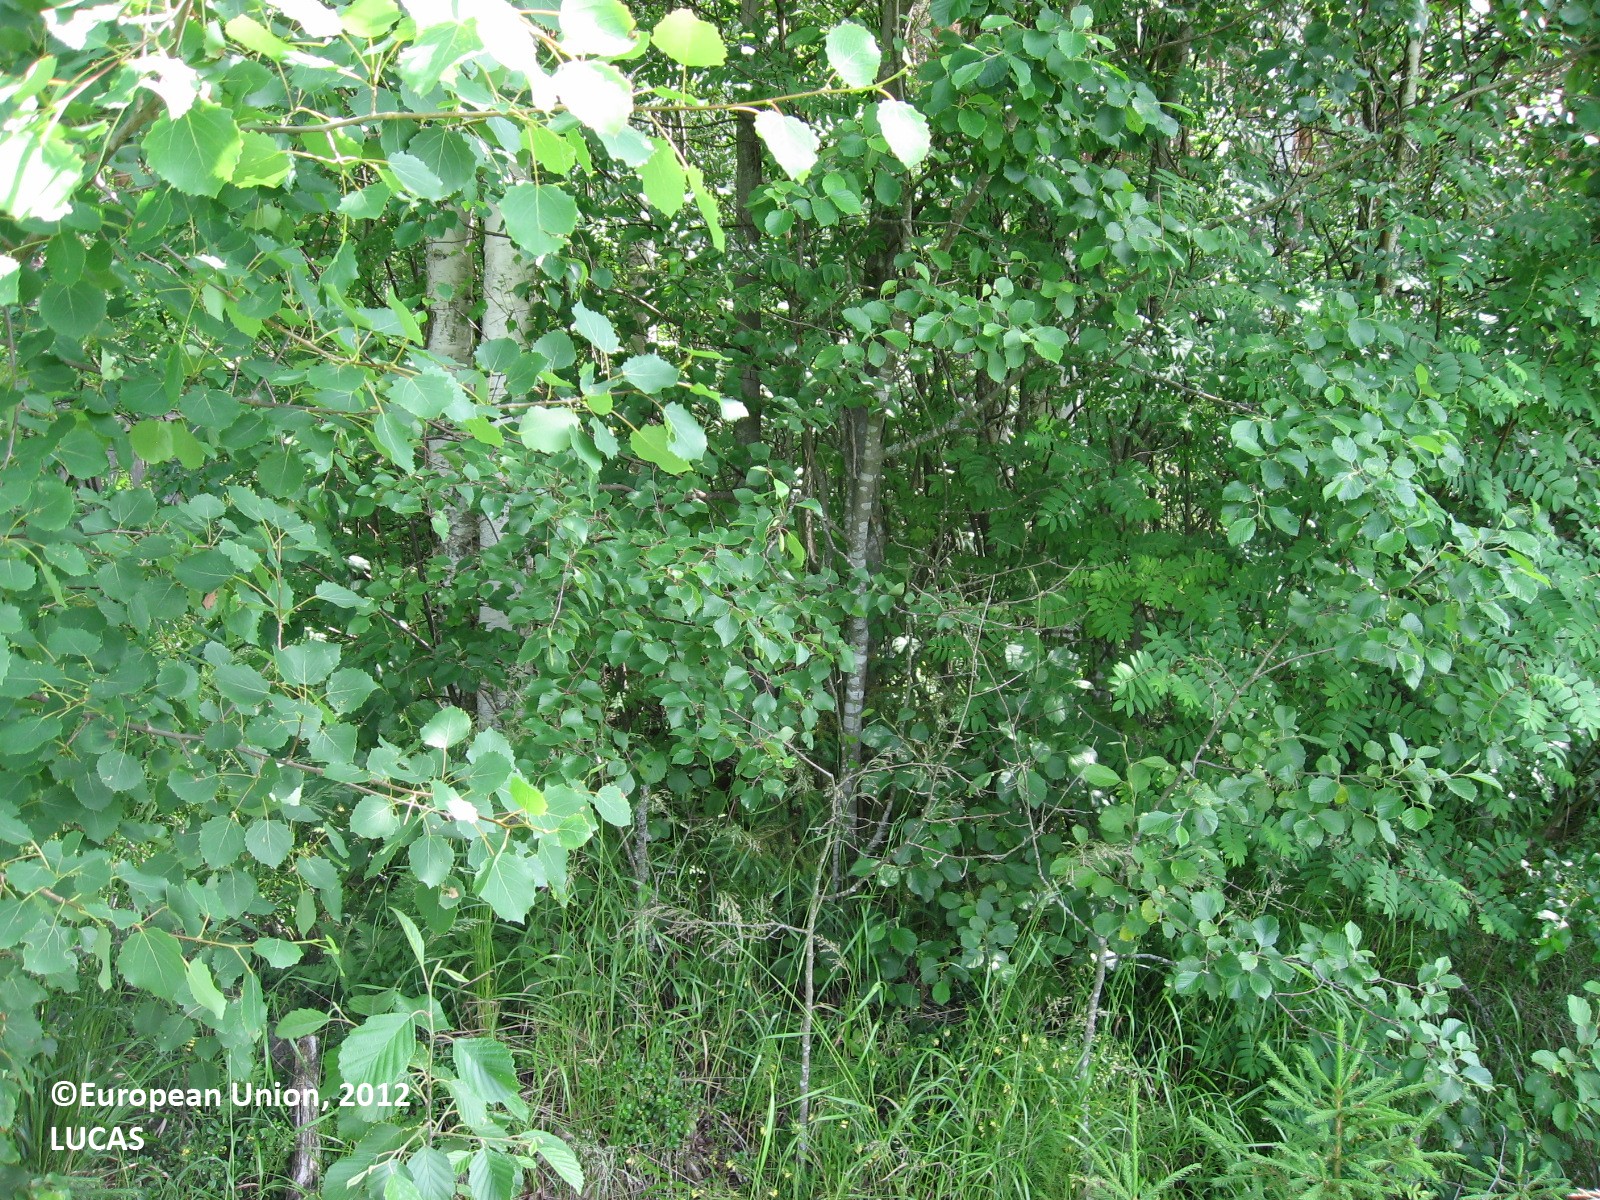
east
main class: Cropland
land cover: Dry pulses
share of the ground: > 75 %
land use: Agriculture (excluding fallow land and kitchen gardens)
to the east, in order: Dry pulses; Ditches and canals; Spruce dominated mixed woodland; Pine dominated mixed woodland; Pine dominated coniferous woodland; Tracks; Pine dominated coniferous woodland
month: July
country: FI
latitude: 60.7431
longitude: 26.2334
